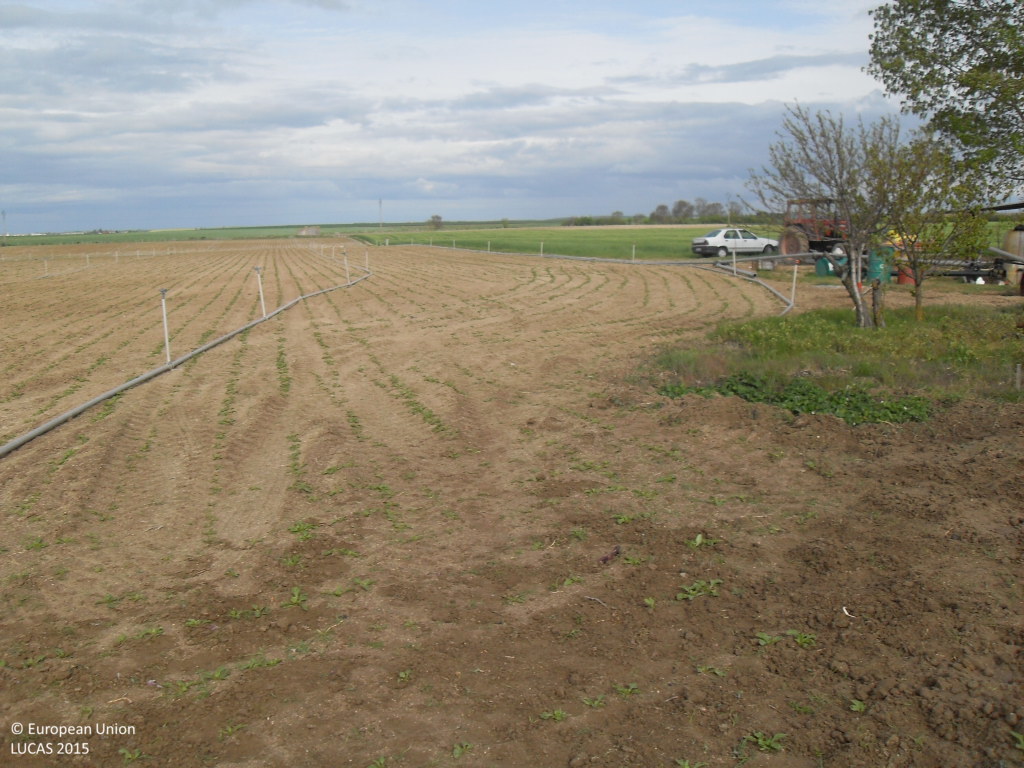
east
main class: Cropland
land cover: Sugar beet
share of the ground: > 75 %
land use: Agriculture (excluding fallow land and kitchen gardens)
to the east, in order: Sugar beet; Tracks; Barley
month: April
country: ES
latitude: 40.9641
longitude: -5.2184
